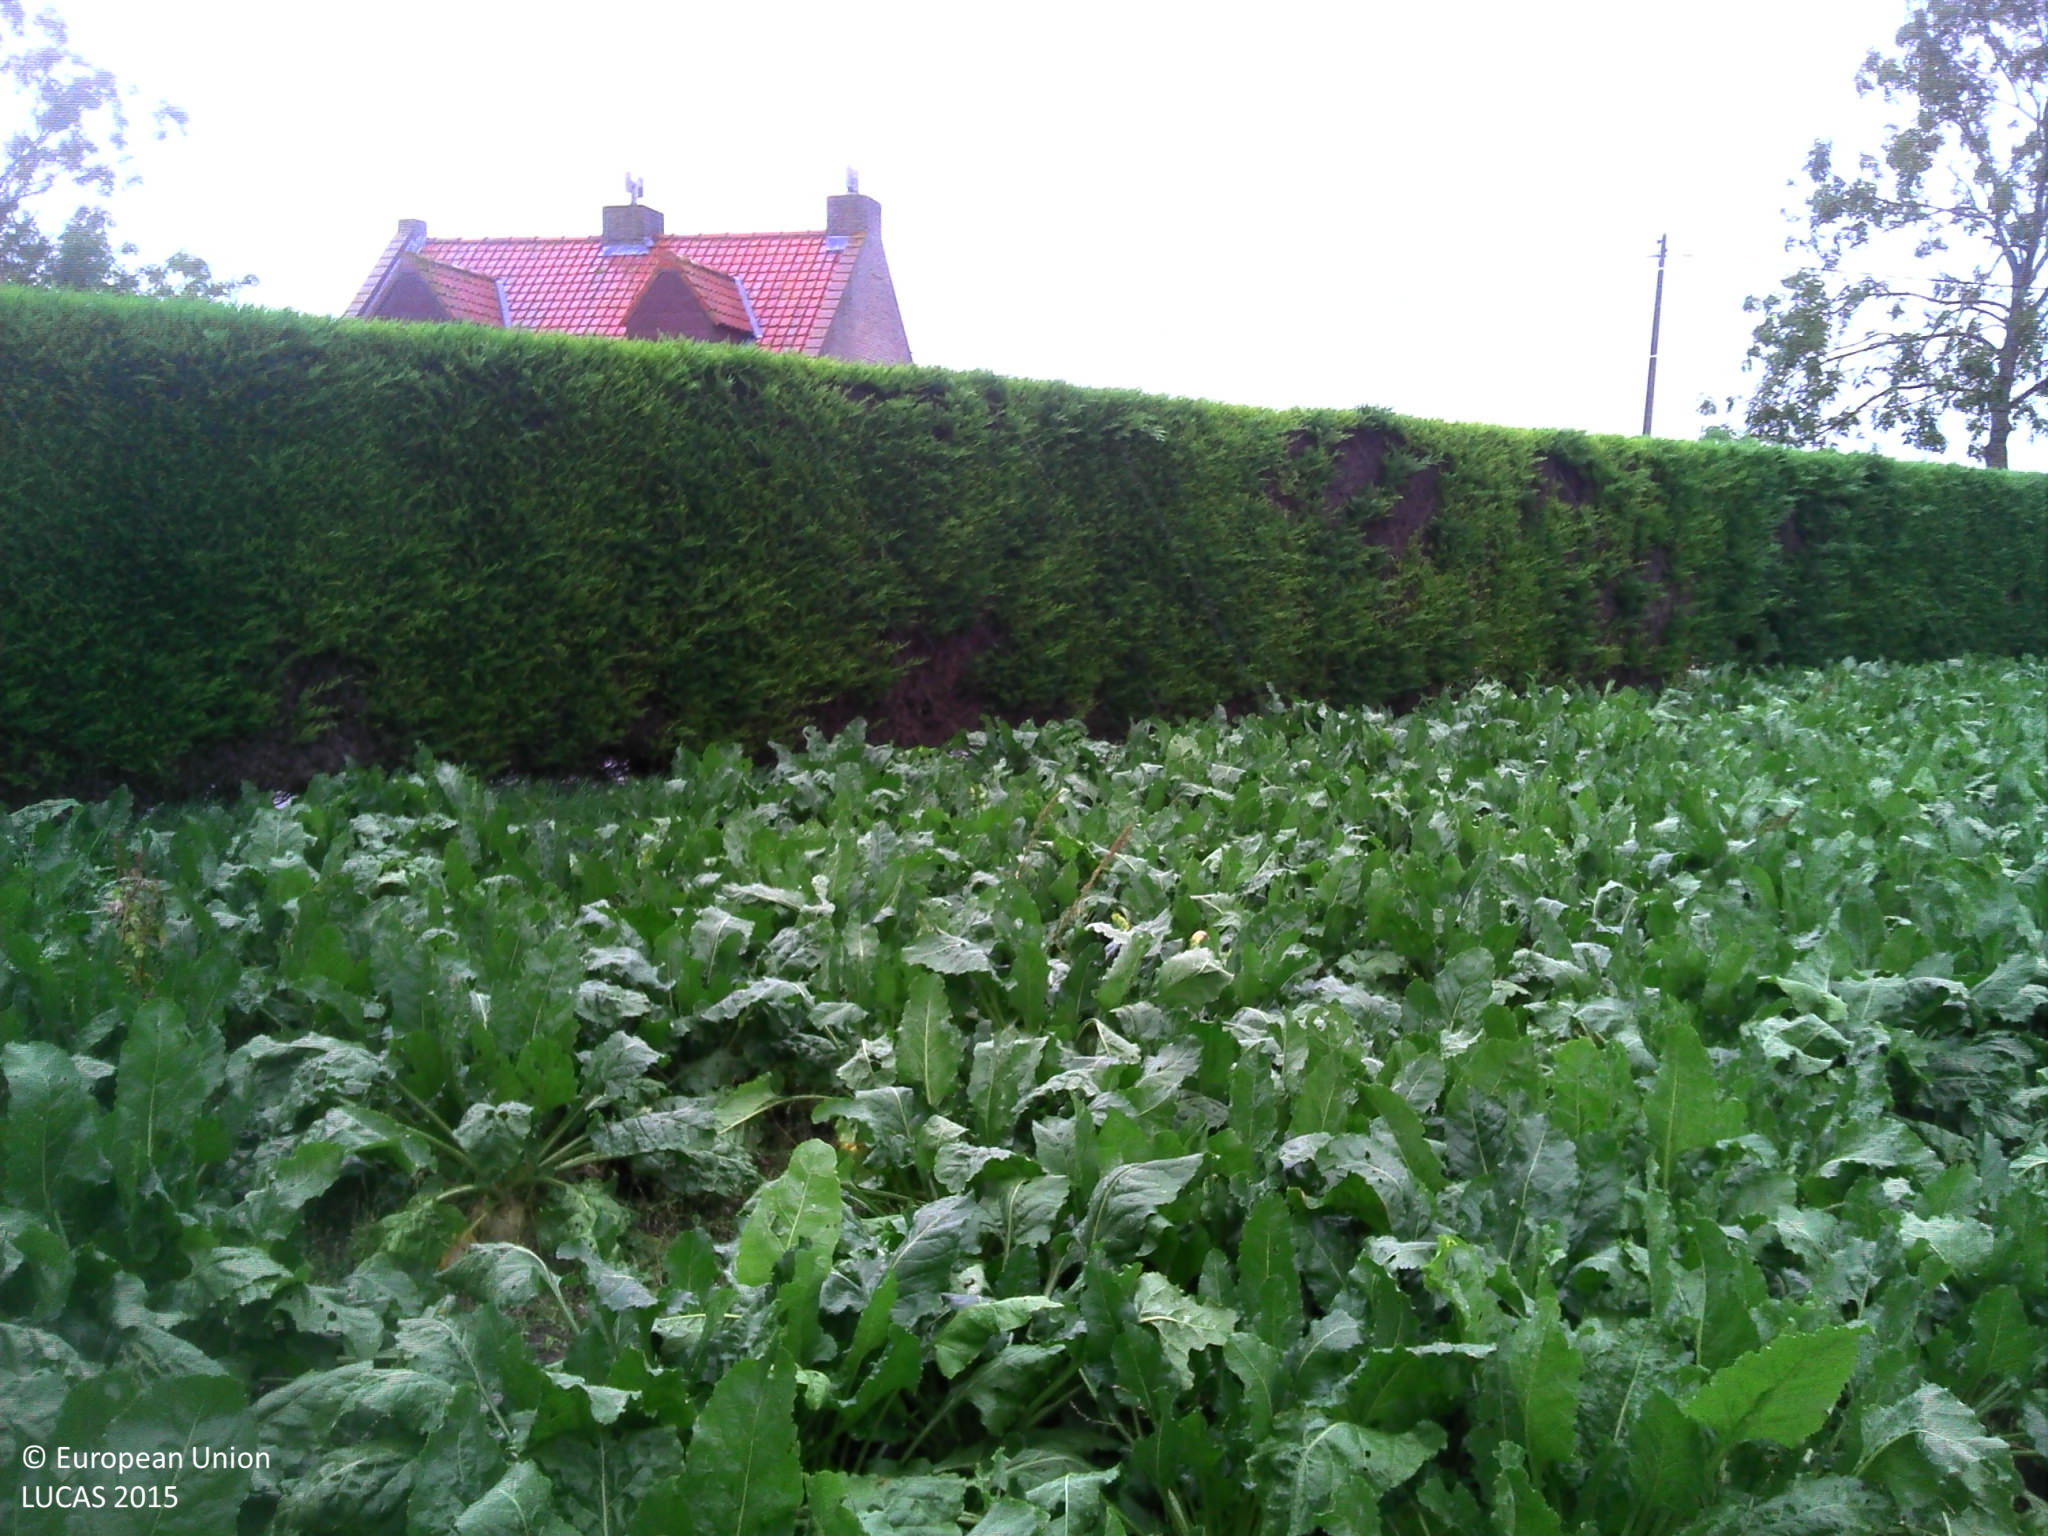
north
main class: Cropland
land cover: Sugar beet
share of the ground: > 75 %
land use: Agriculture (excluding fallow land and kitchen gardens)
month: September
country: BE
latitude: 51.1103
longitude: 2.7754
